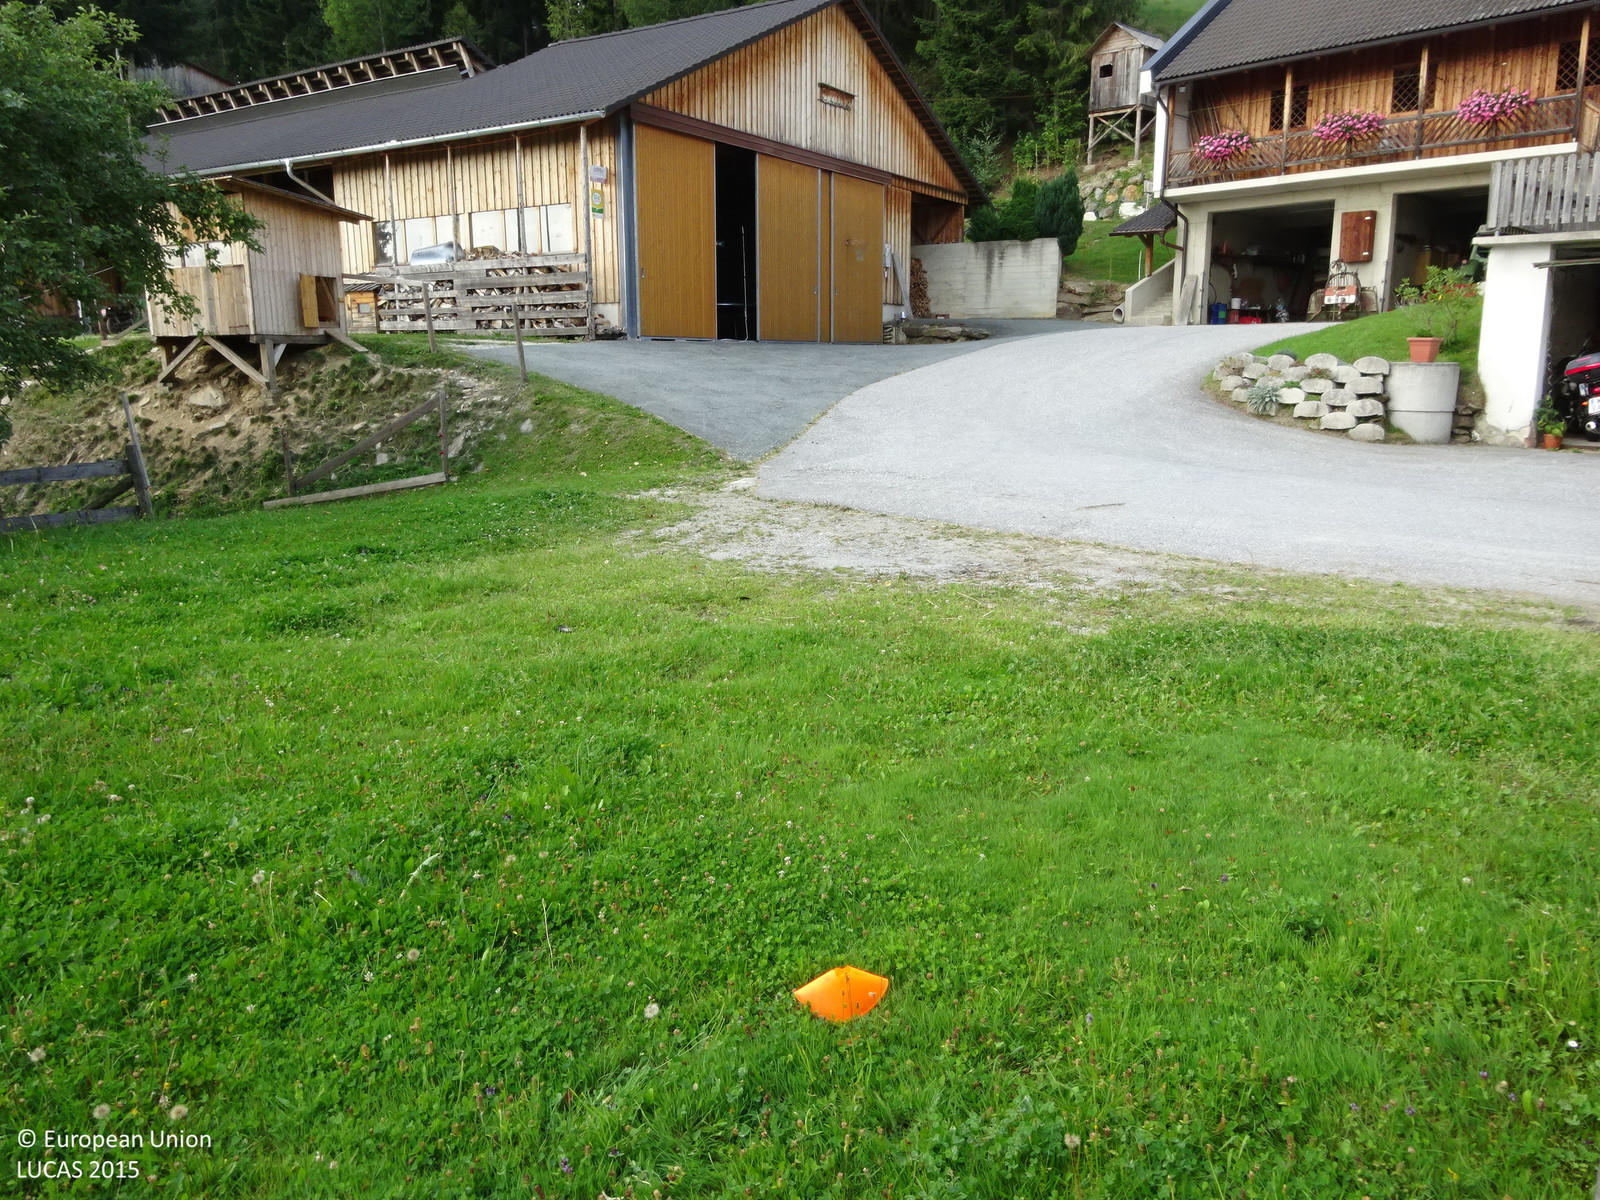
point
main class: Grassland
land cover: Grassland without tree/shrub cover
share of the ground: > 75 %
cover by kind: herbaceous plants 100 %
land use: Amenities, museums, leisure
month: August
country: AT
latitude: 47.5127
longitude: 15.7777
